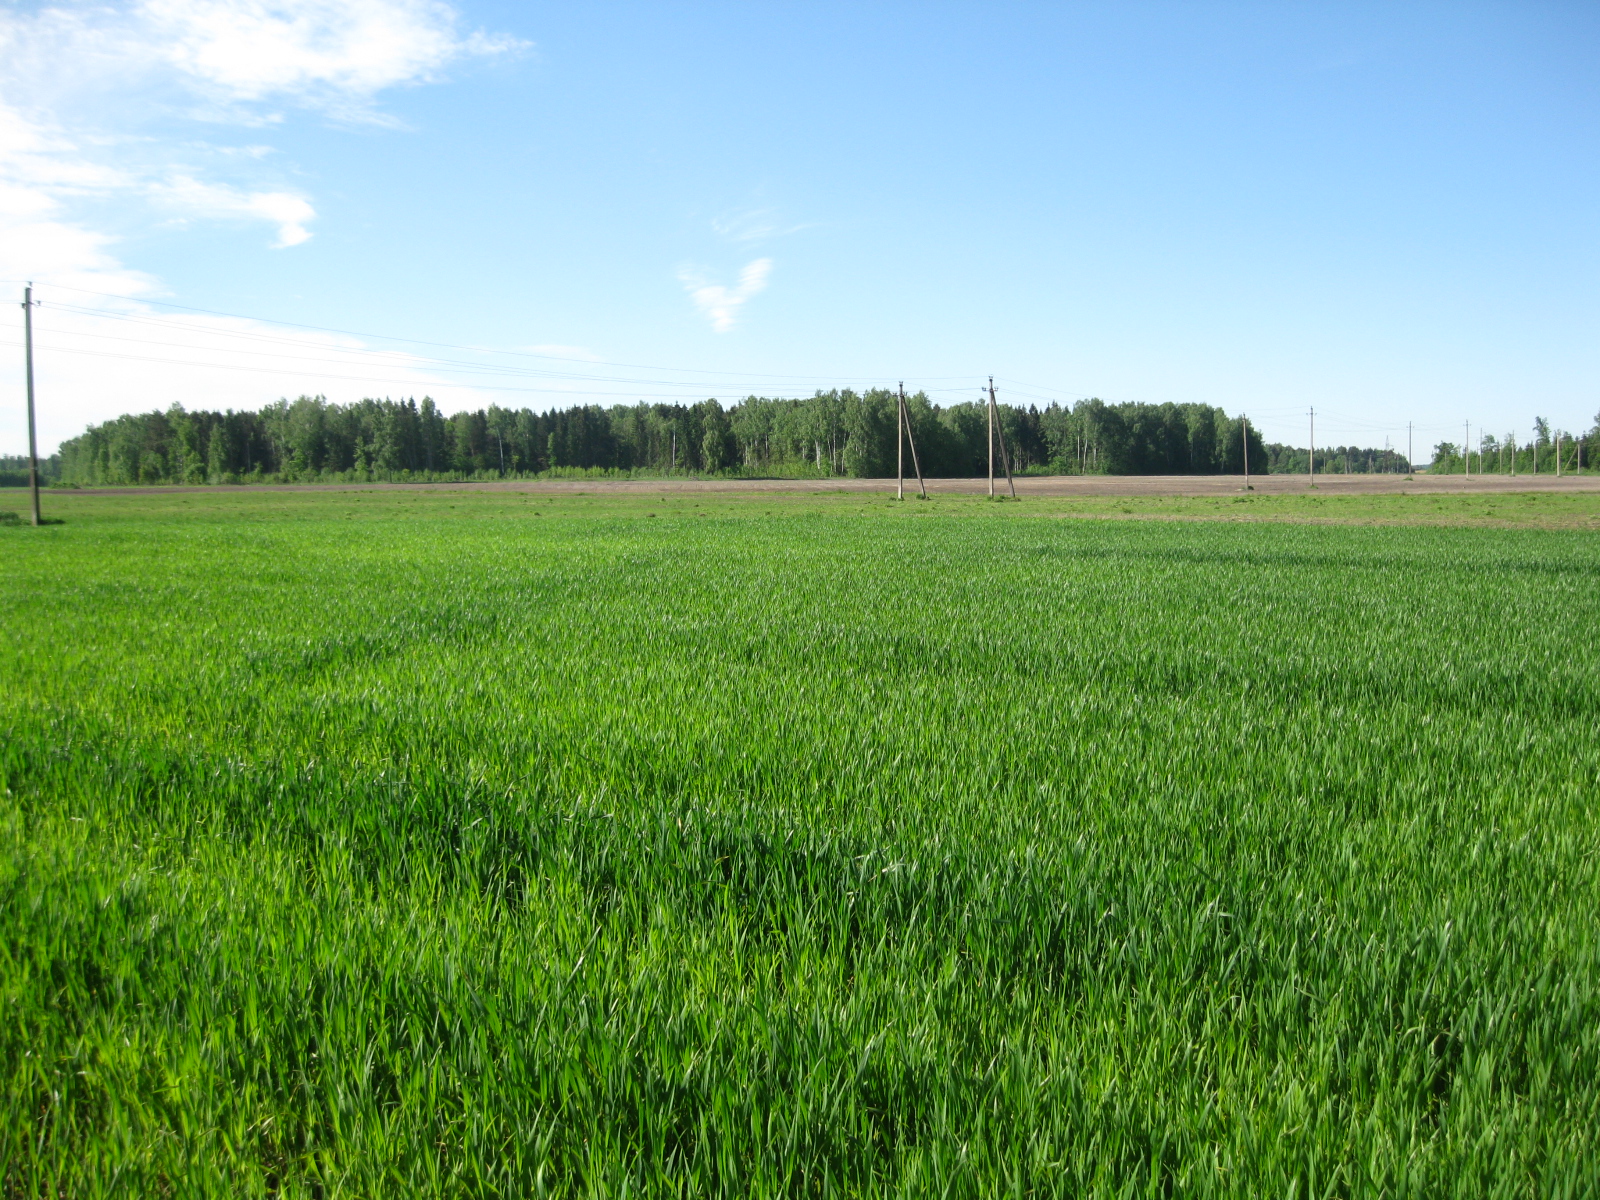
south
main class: Cropland
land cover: Common wheat
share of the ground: > 75 %
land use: Agriculture (excluding fallow land and kitchen gardens)
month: May
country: LT
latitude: 55.8359
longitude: 24.3215
